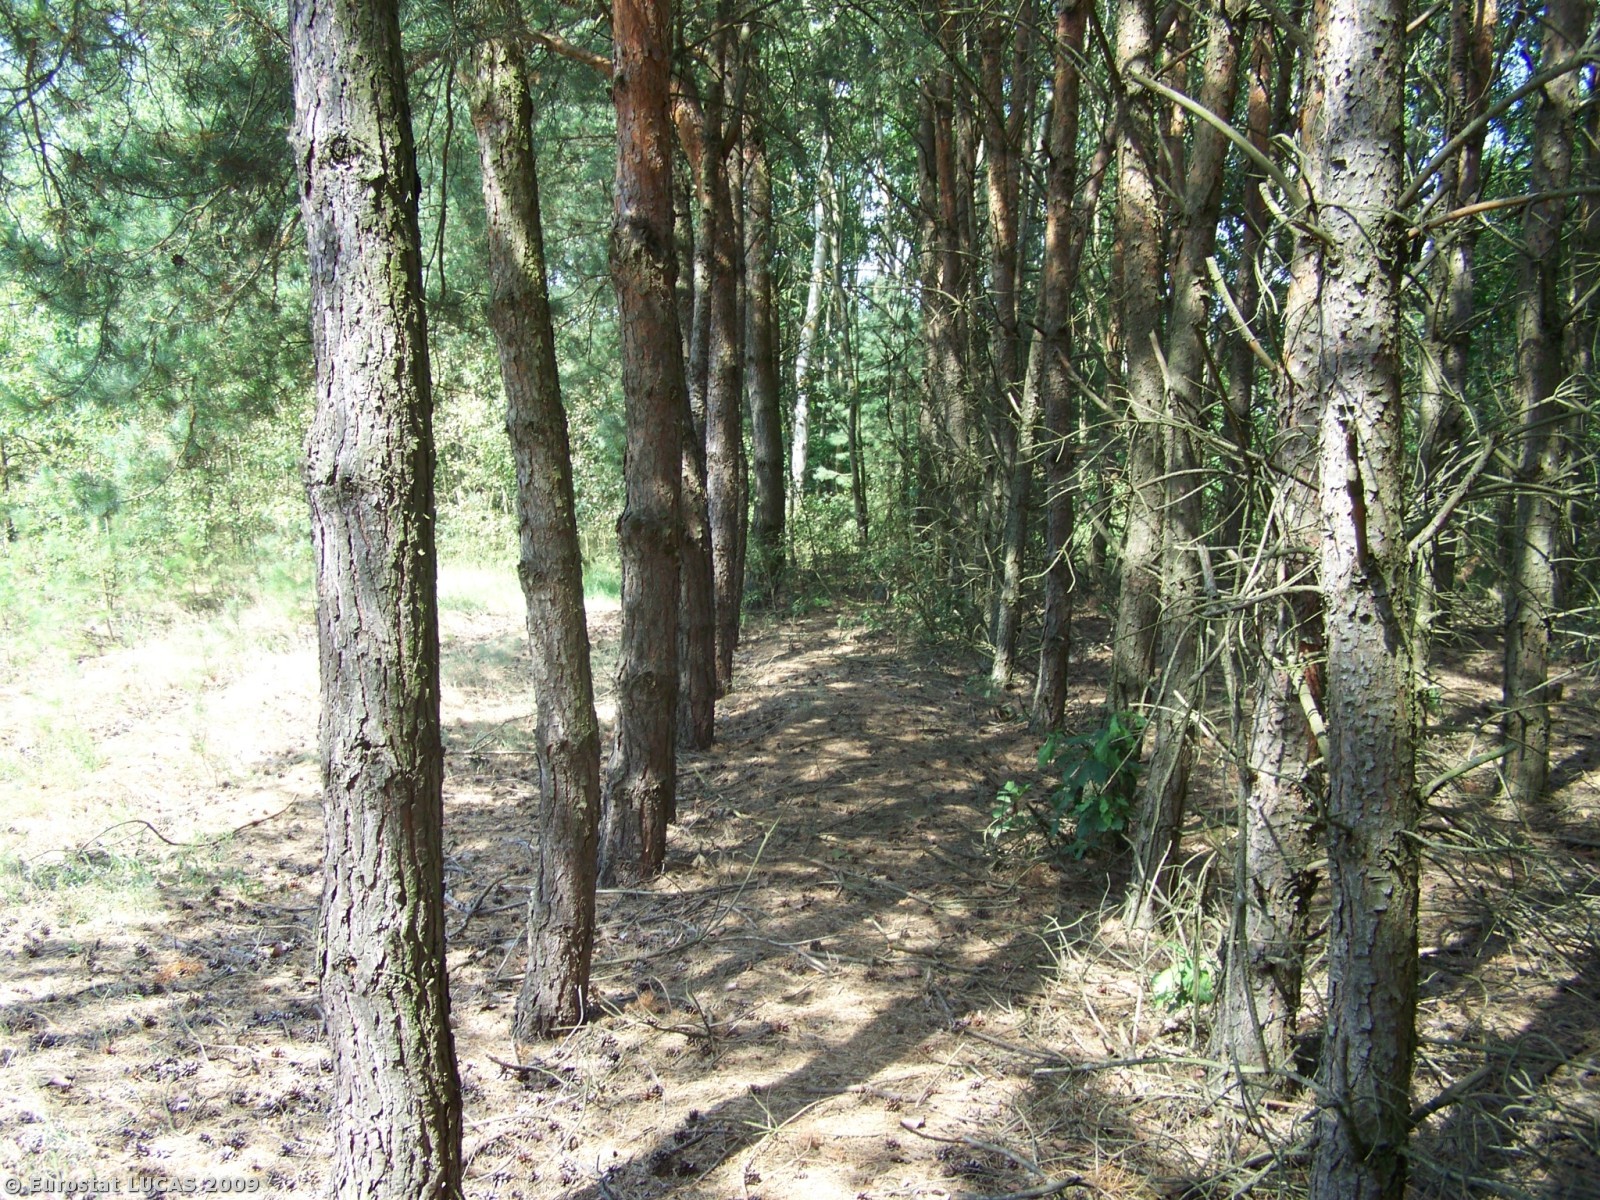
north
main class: Woodland
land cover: Coniferous woodland
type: hemiboreal forest and nemoral coniferous forest and mixed broadleaved-coniferous forest
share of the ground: > 75 %
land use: Forestry
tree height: > 5 m
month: July
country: PL
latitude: 52.0772
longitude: 22.1568
